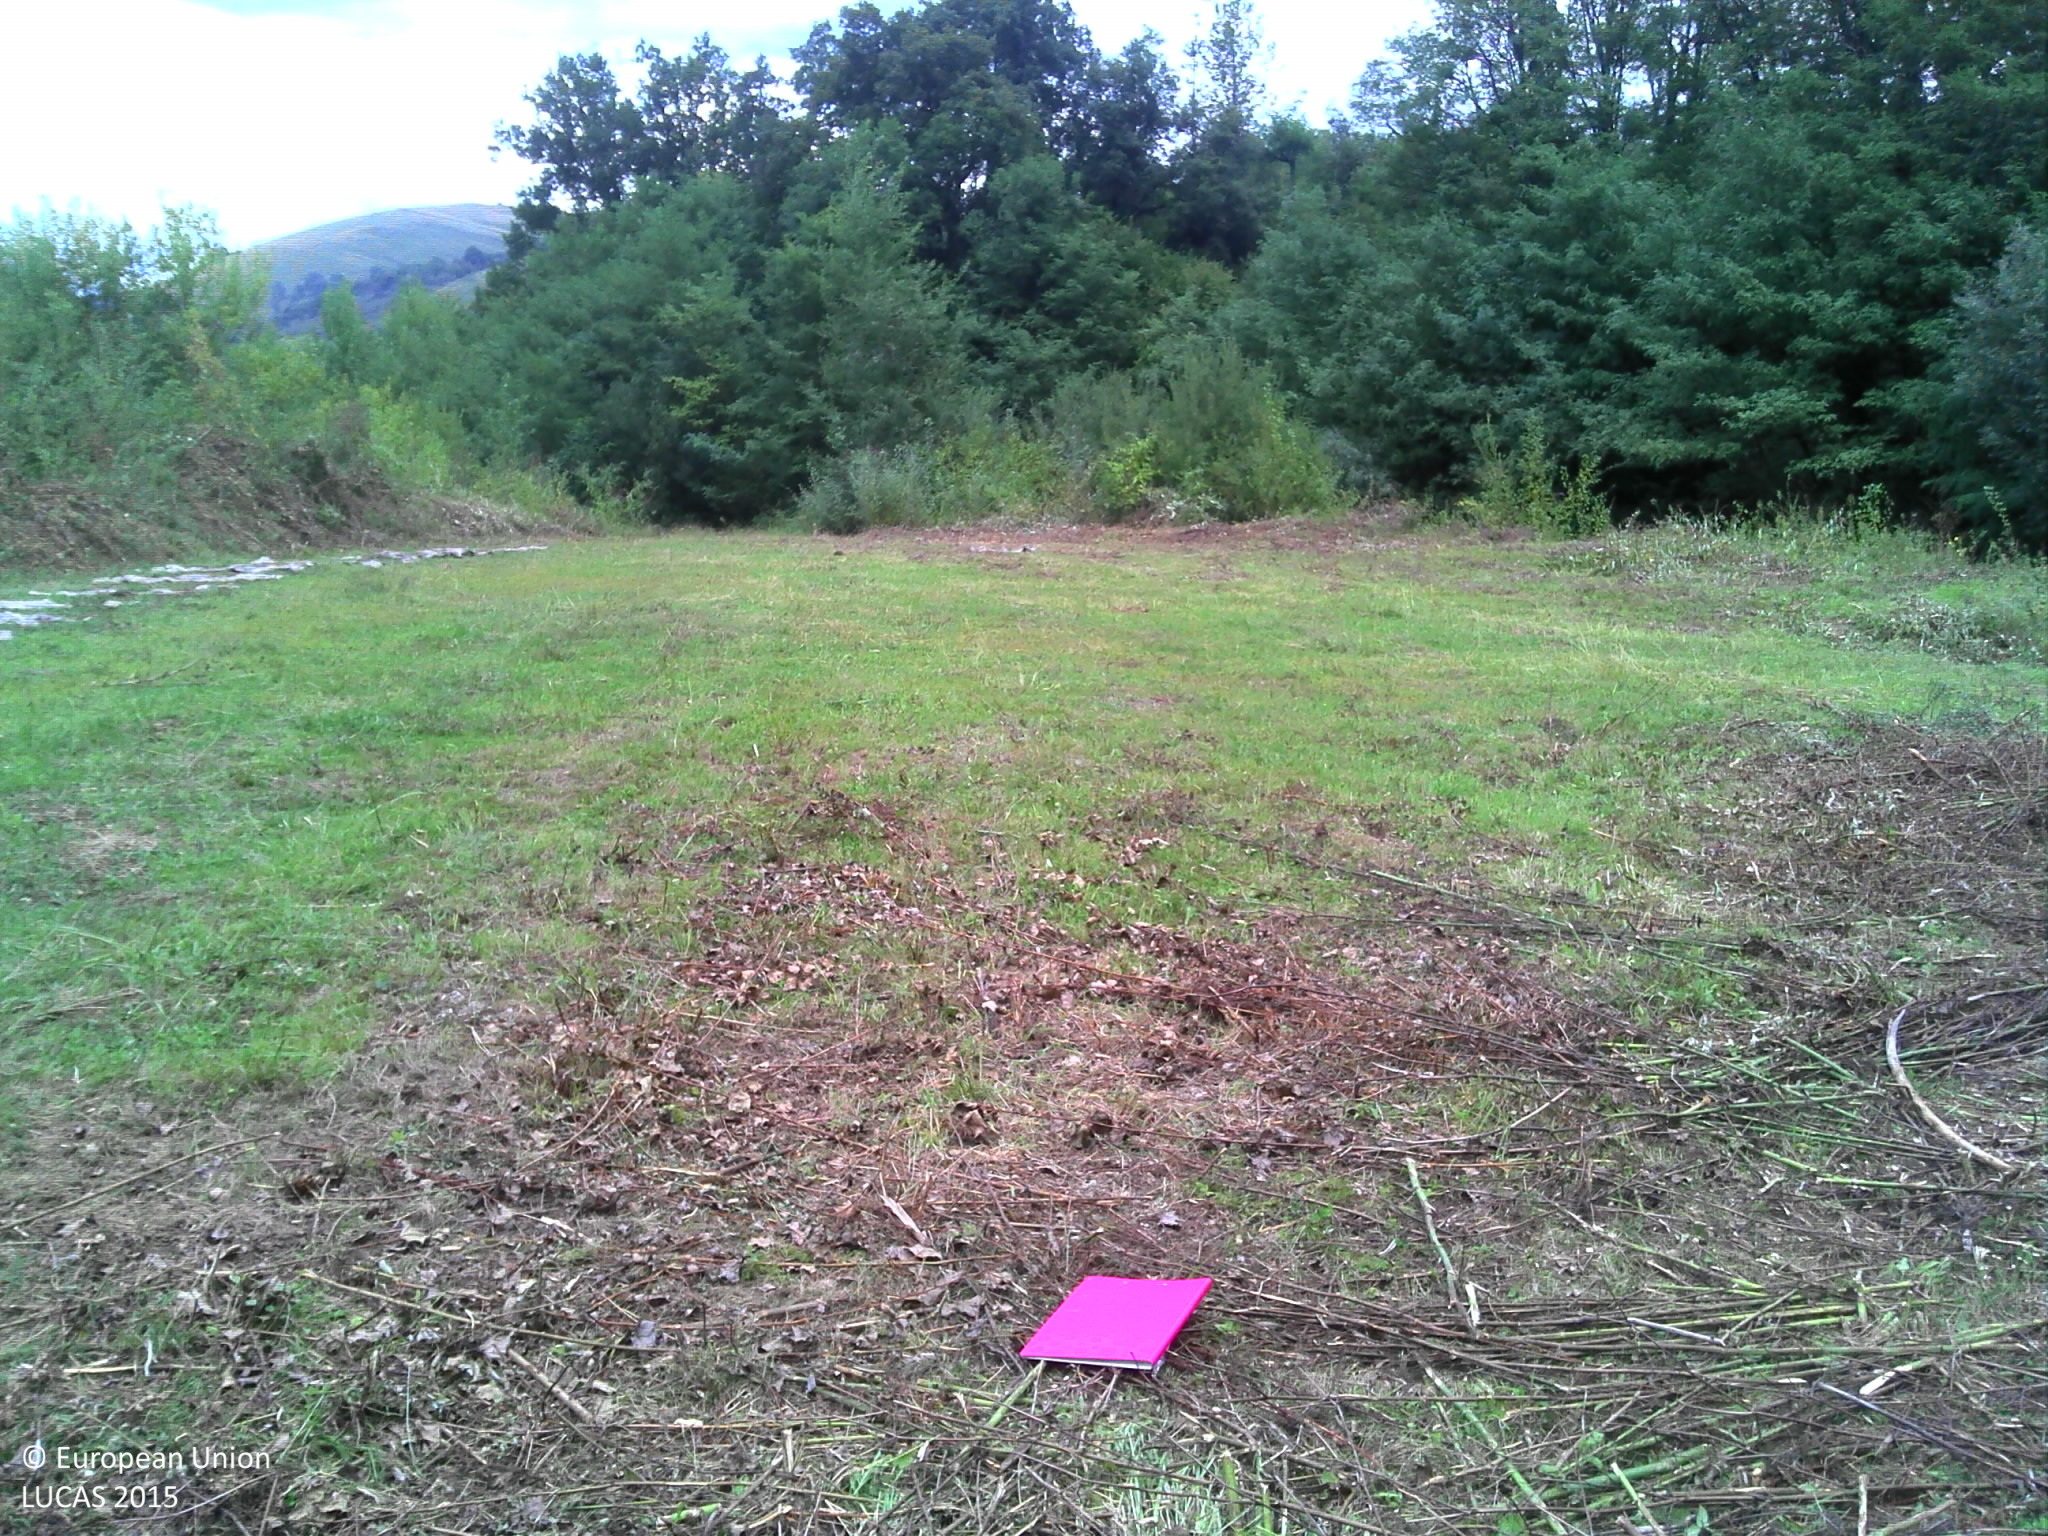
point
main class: Grassland
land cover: Grassland without tree/shrub cover
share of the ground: > 75 %
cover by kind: herbaceous plants 80 %, unconsolidated bare surface 15 %, shrubs 5 %
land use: Agriculture (excluding fallow land and kitchen gardens)
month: September
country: FR
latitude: 43.1746
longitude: -0.8972
